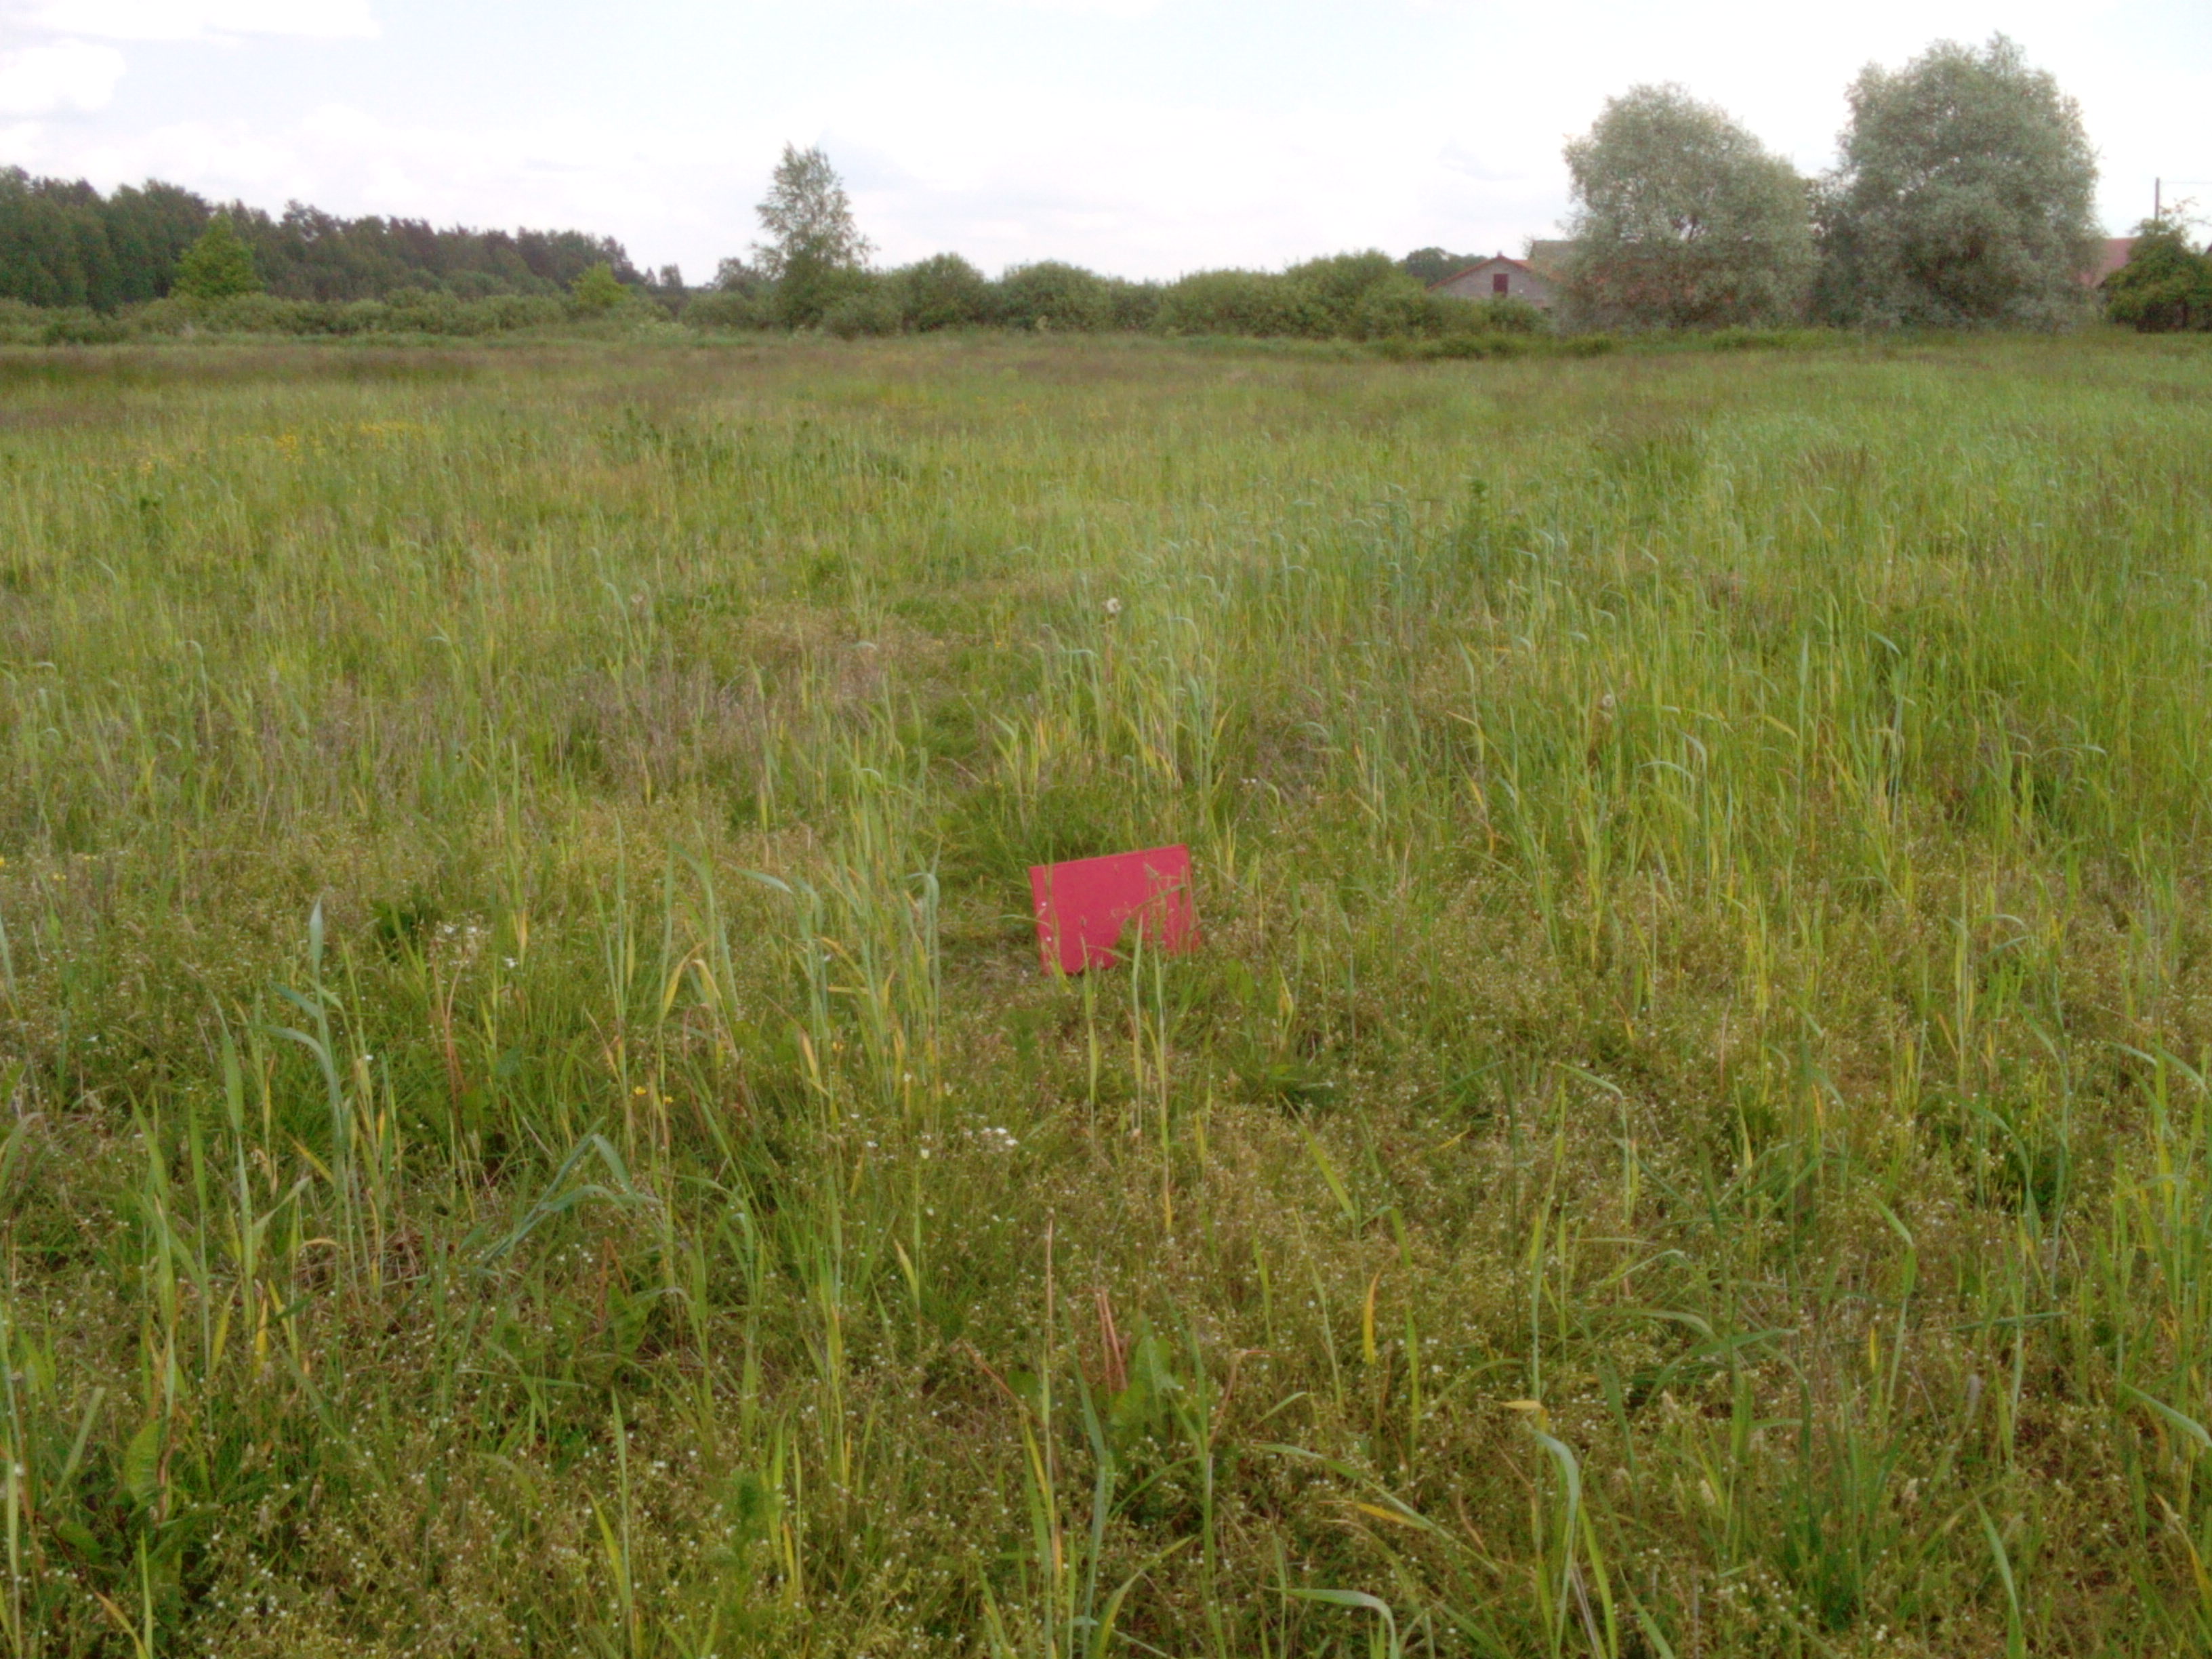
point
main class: Grassland
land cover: Grassland without tree/shrub cover
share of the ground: > 75 %
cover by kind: herbaceous plants 100 %
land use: Agriculture (excluding fallow land and kitchen gardens)
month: June
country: LV
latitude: 56.8146
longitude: 22.2894
